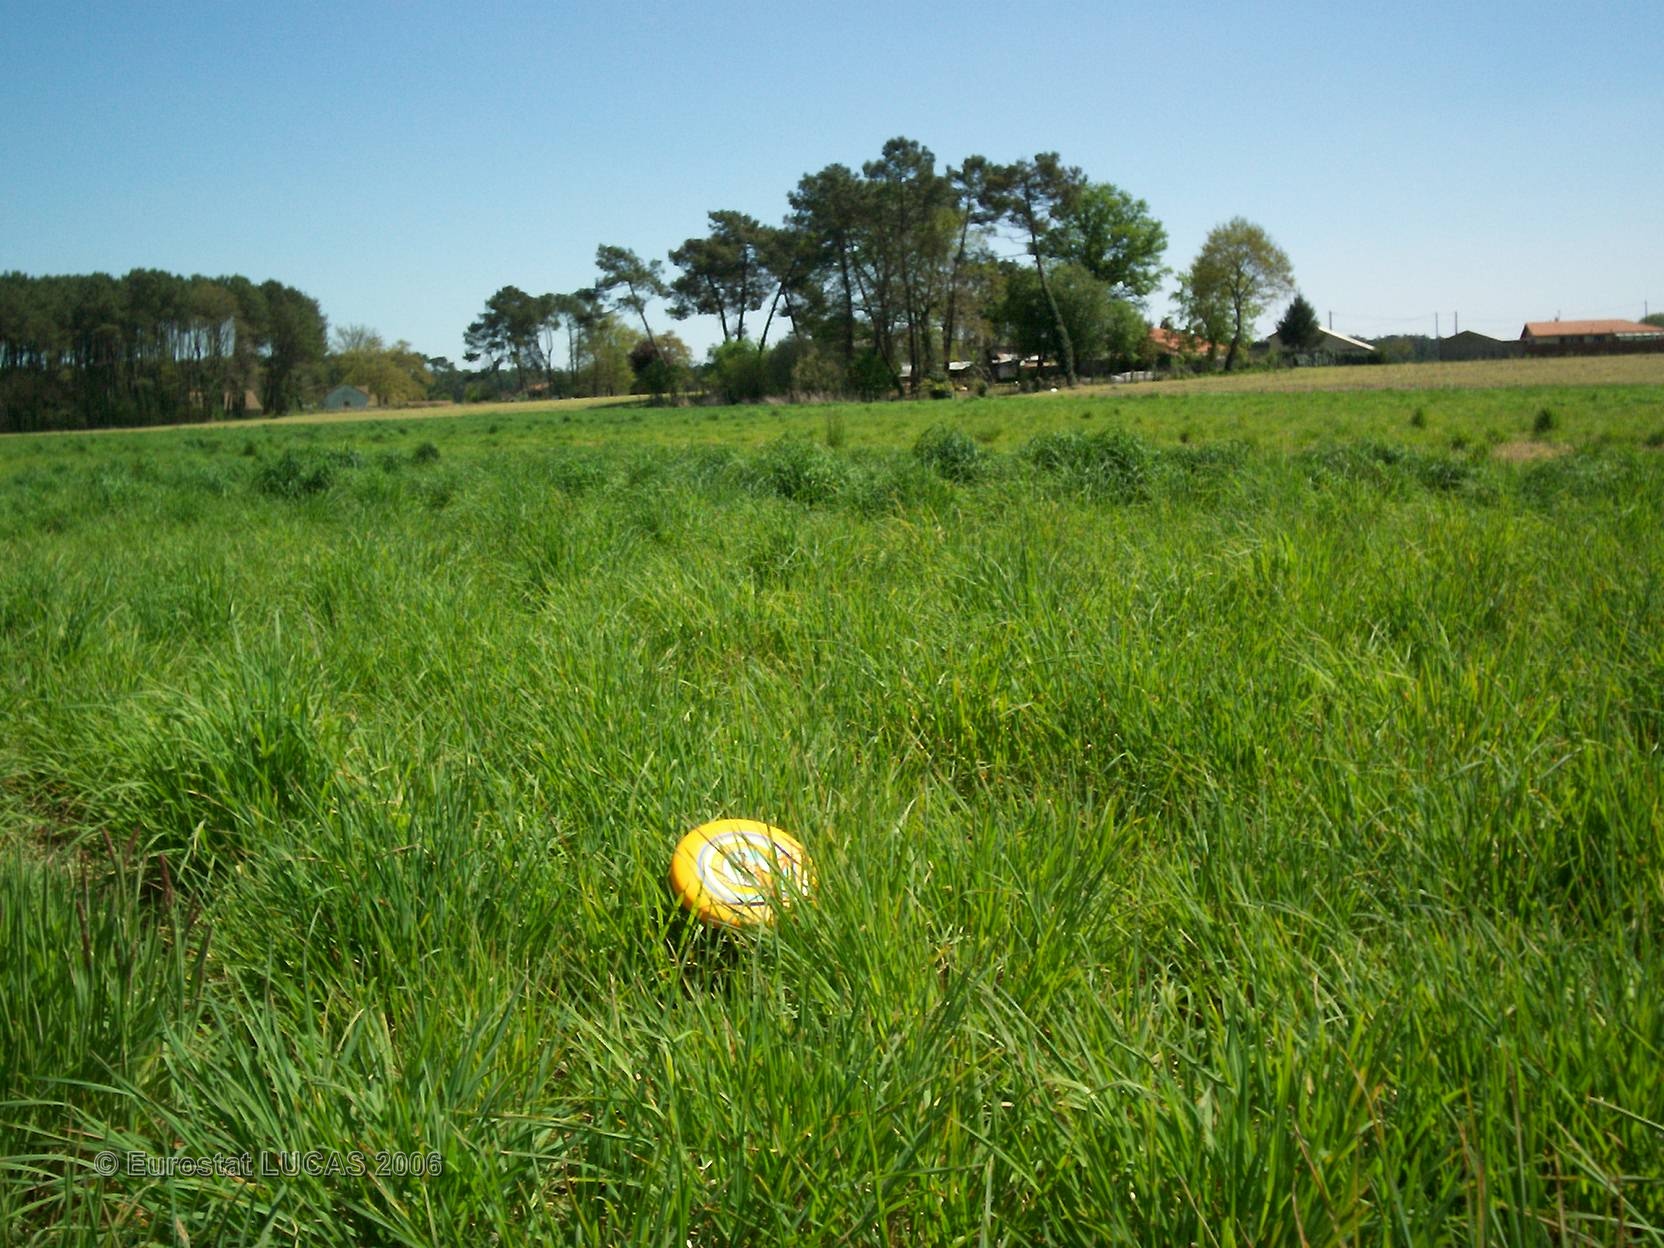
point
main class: Grassland
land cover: Grassland without tree/shrub cover
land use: Agriculture (excluding fallow land and kitchen gardens)
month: April
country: FR
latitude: 43.8121
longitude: -0.7170
